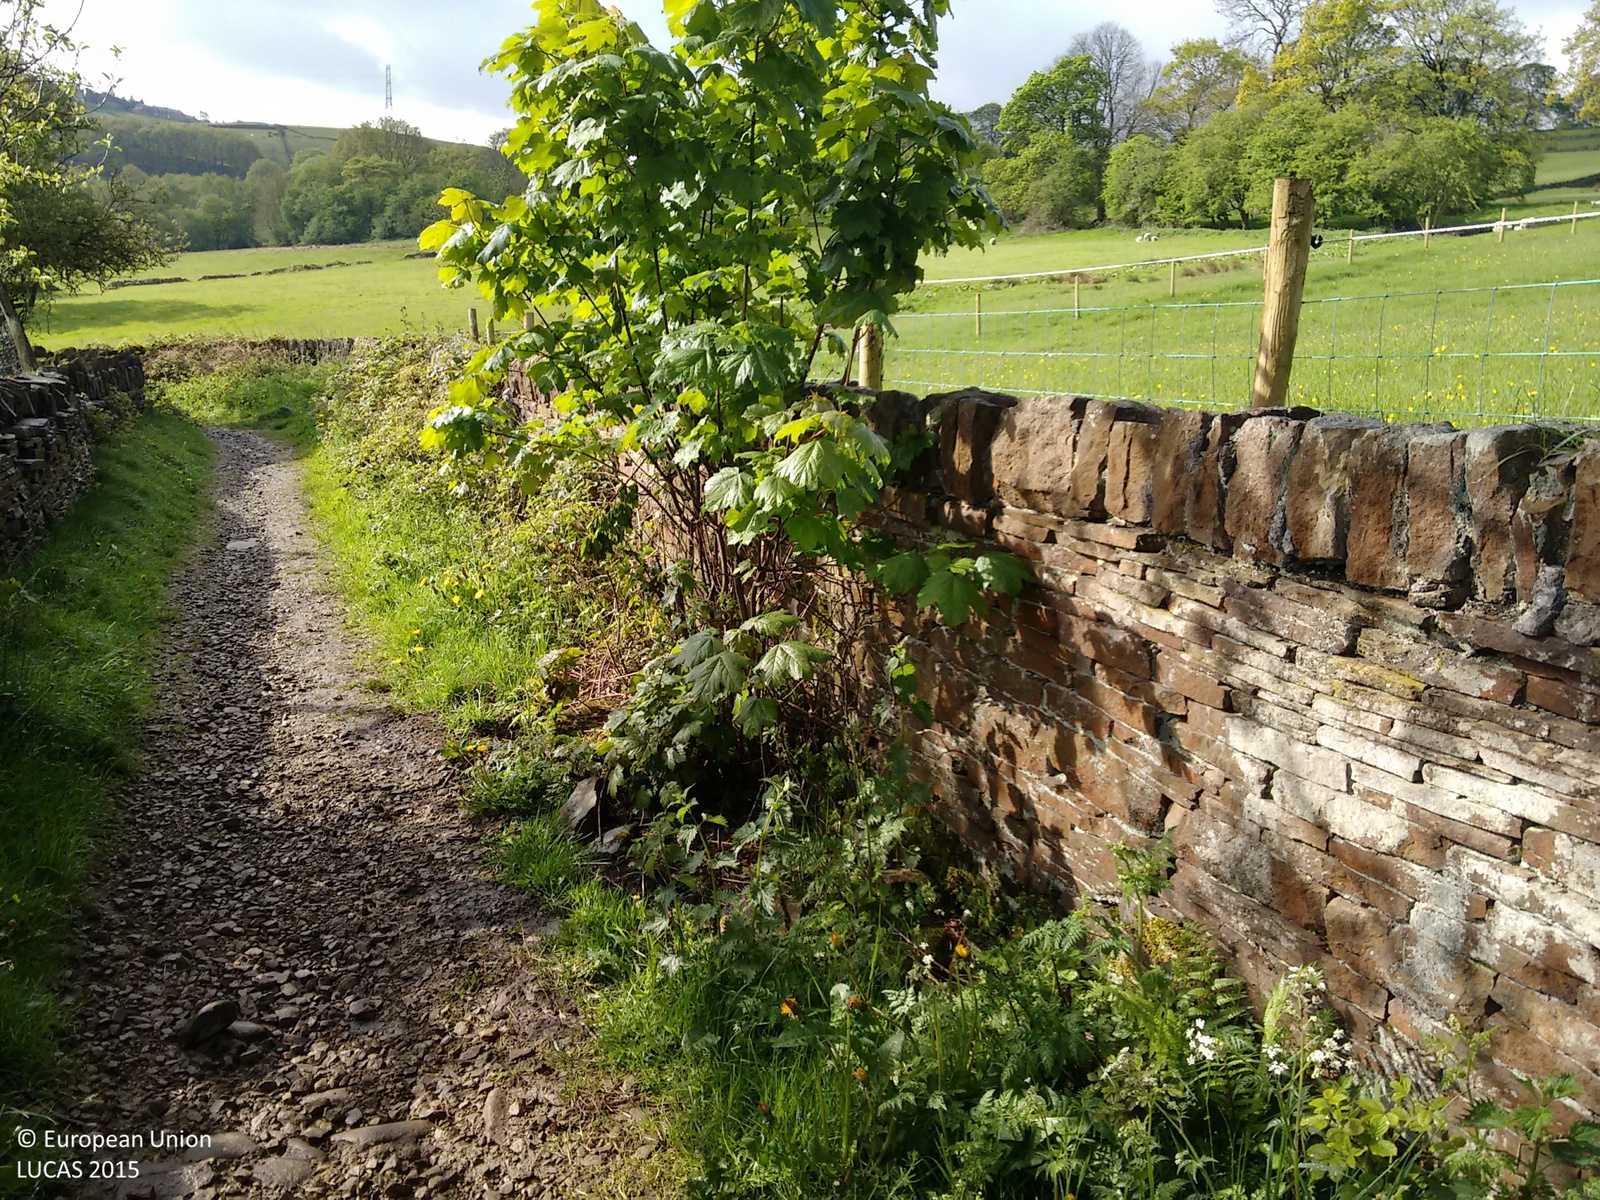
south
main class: Grassland
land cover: Grassland without tree/shrub cover
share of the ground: > 75 %
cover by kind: herbaceous plants 100 %
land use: Agriculture (excluding fallow land and kitchen gardens)
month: May
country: GB
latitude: 53.6696
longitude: -1.8765
